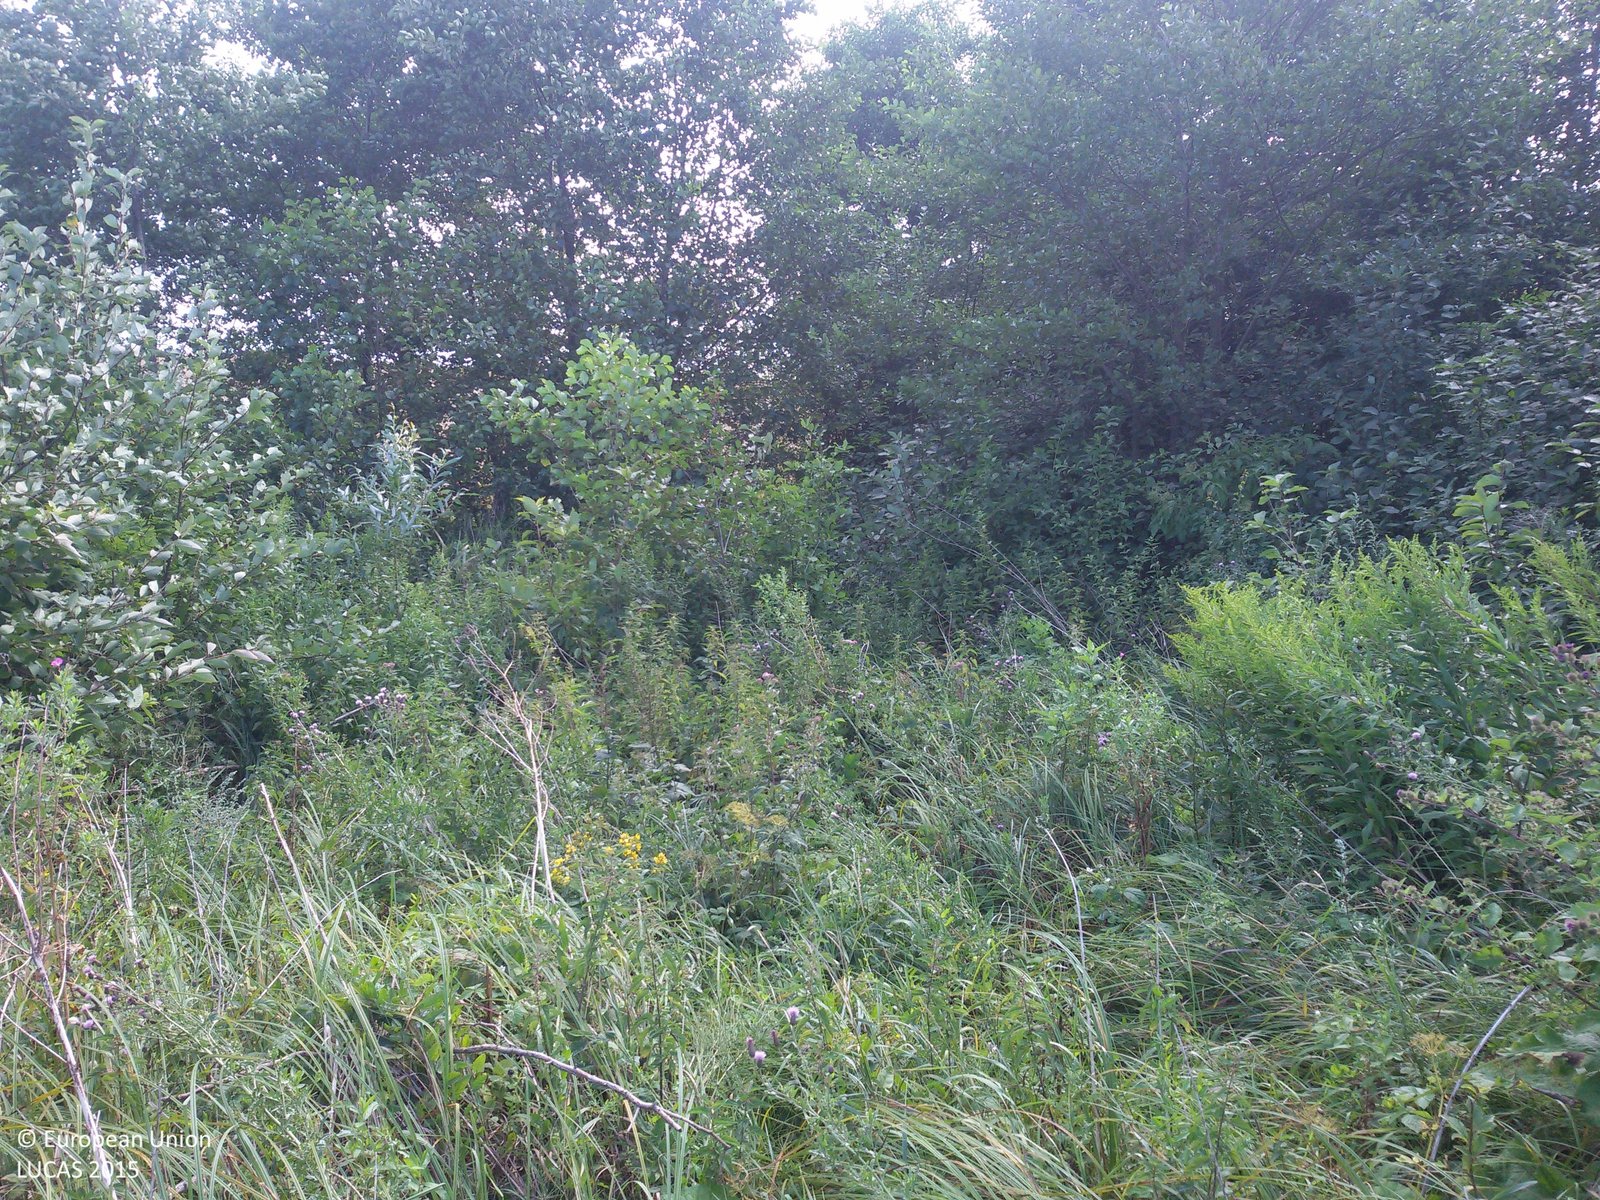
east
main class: Grassland
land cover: Spontaneously vegetated surfaces
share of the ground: > 75 %
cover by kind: herbaceous plants 95 %, shrubs 5 %
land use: Semi-natural and natural areas not in use
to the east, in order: Spontaneously vegetated surfaces; Broadleaved woodland; Common wheat; Spontaneously vegetated surfaces; Inland marshes; Inland fresh water bodies; Inland marshes; Broadleaved woodland
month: July
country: PL
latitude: 52.8932
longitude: 19.1355
